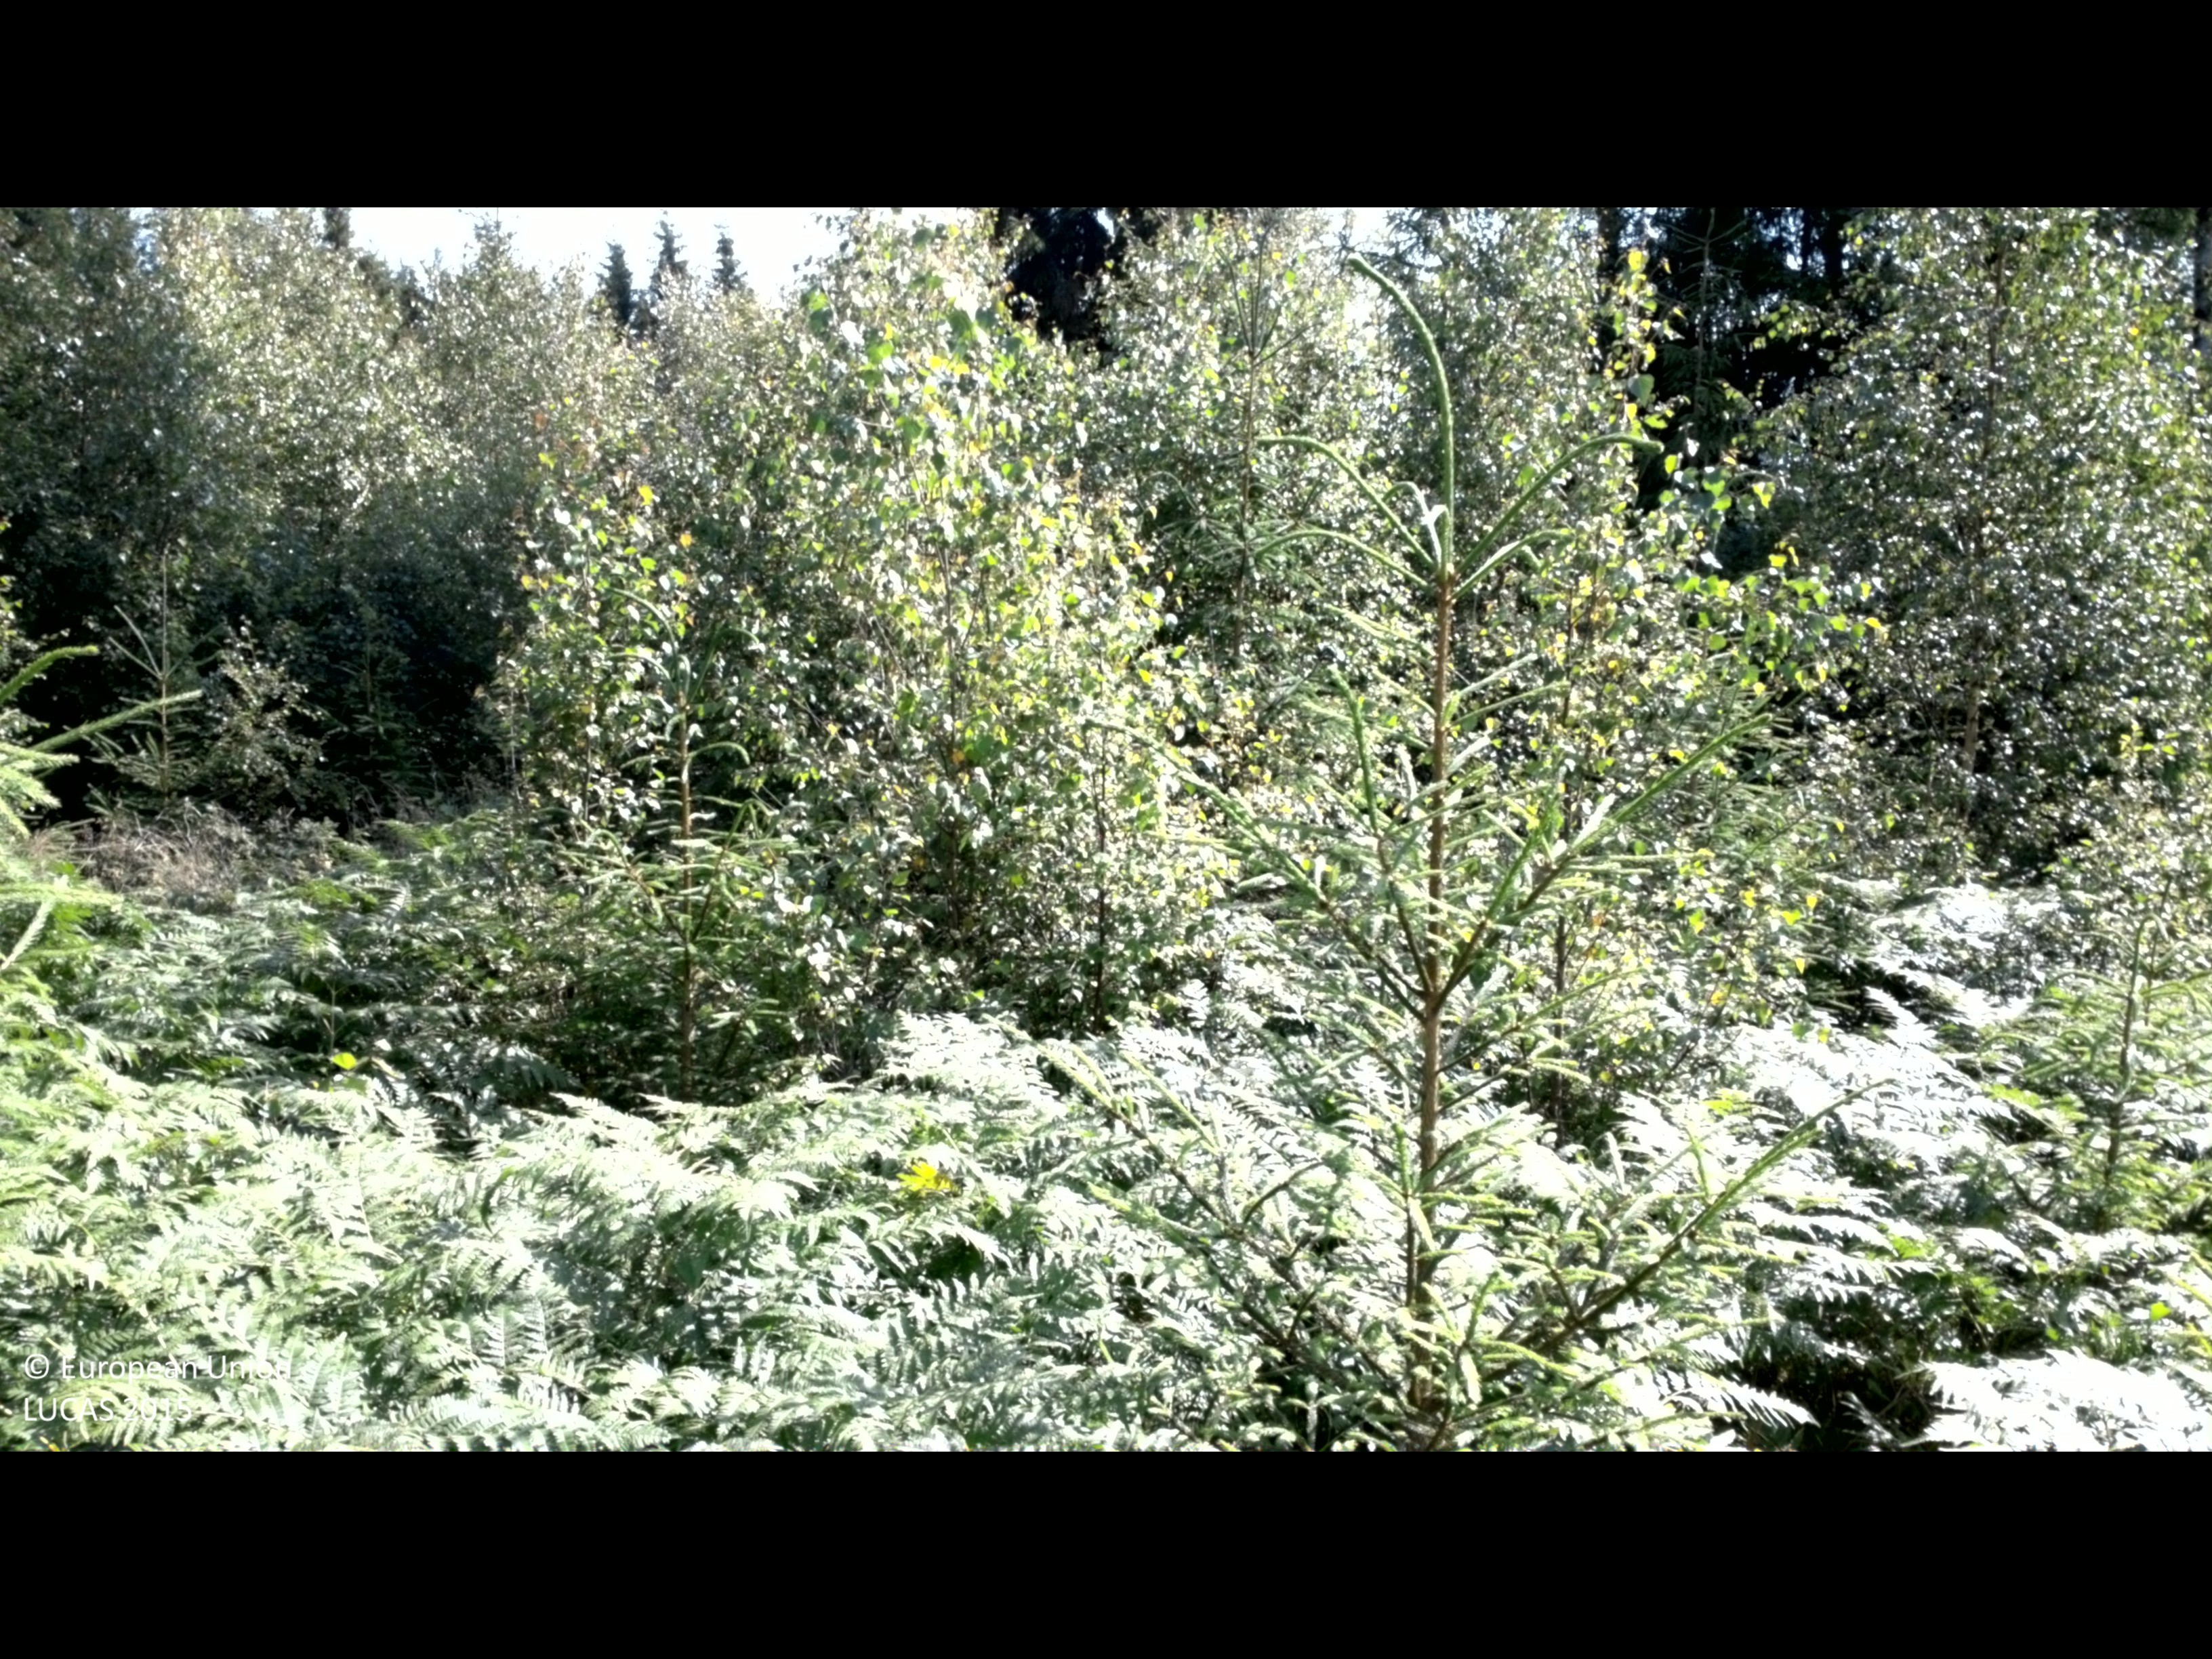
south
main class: Woodland
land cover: Broadleaved woodland
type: boreal forest
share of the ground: 50 - 75 %
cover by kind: broadleaved forest trees 55 %, herbaceous plants 20 %, coniferous forest trees 15 %, shrubs 10 %
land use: Forestry
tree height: < 5 m
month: July
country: SE
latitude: 56.4949
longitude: 14.2692
